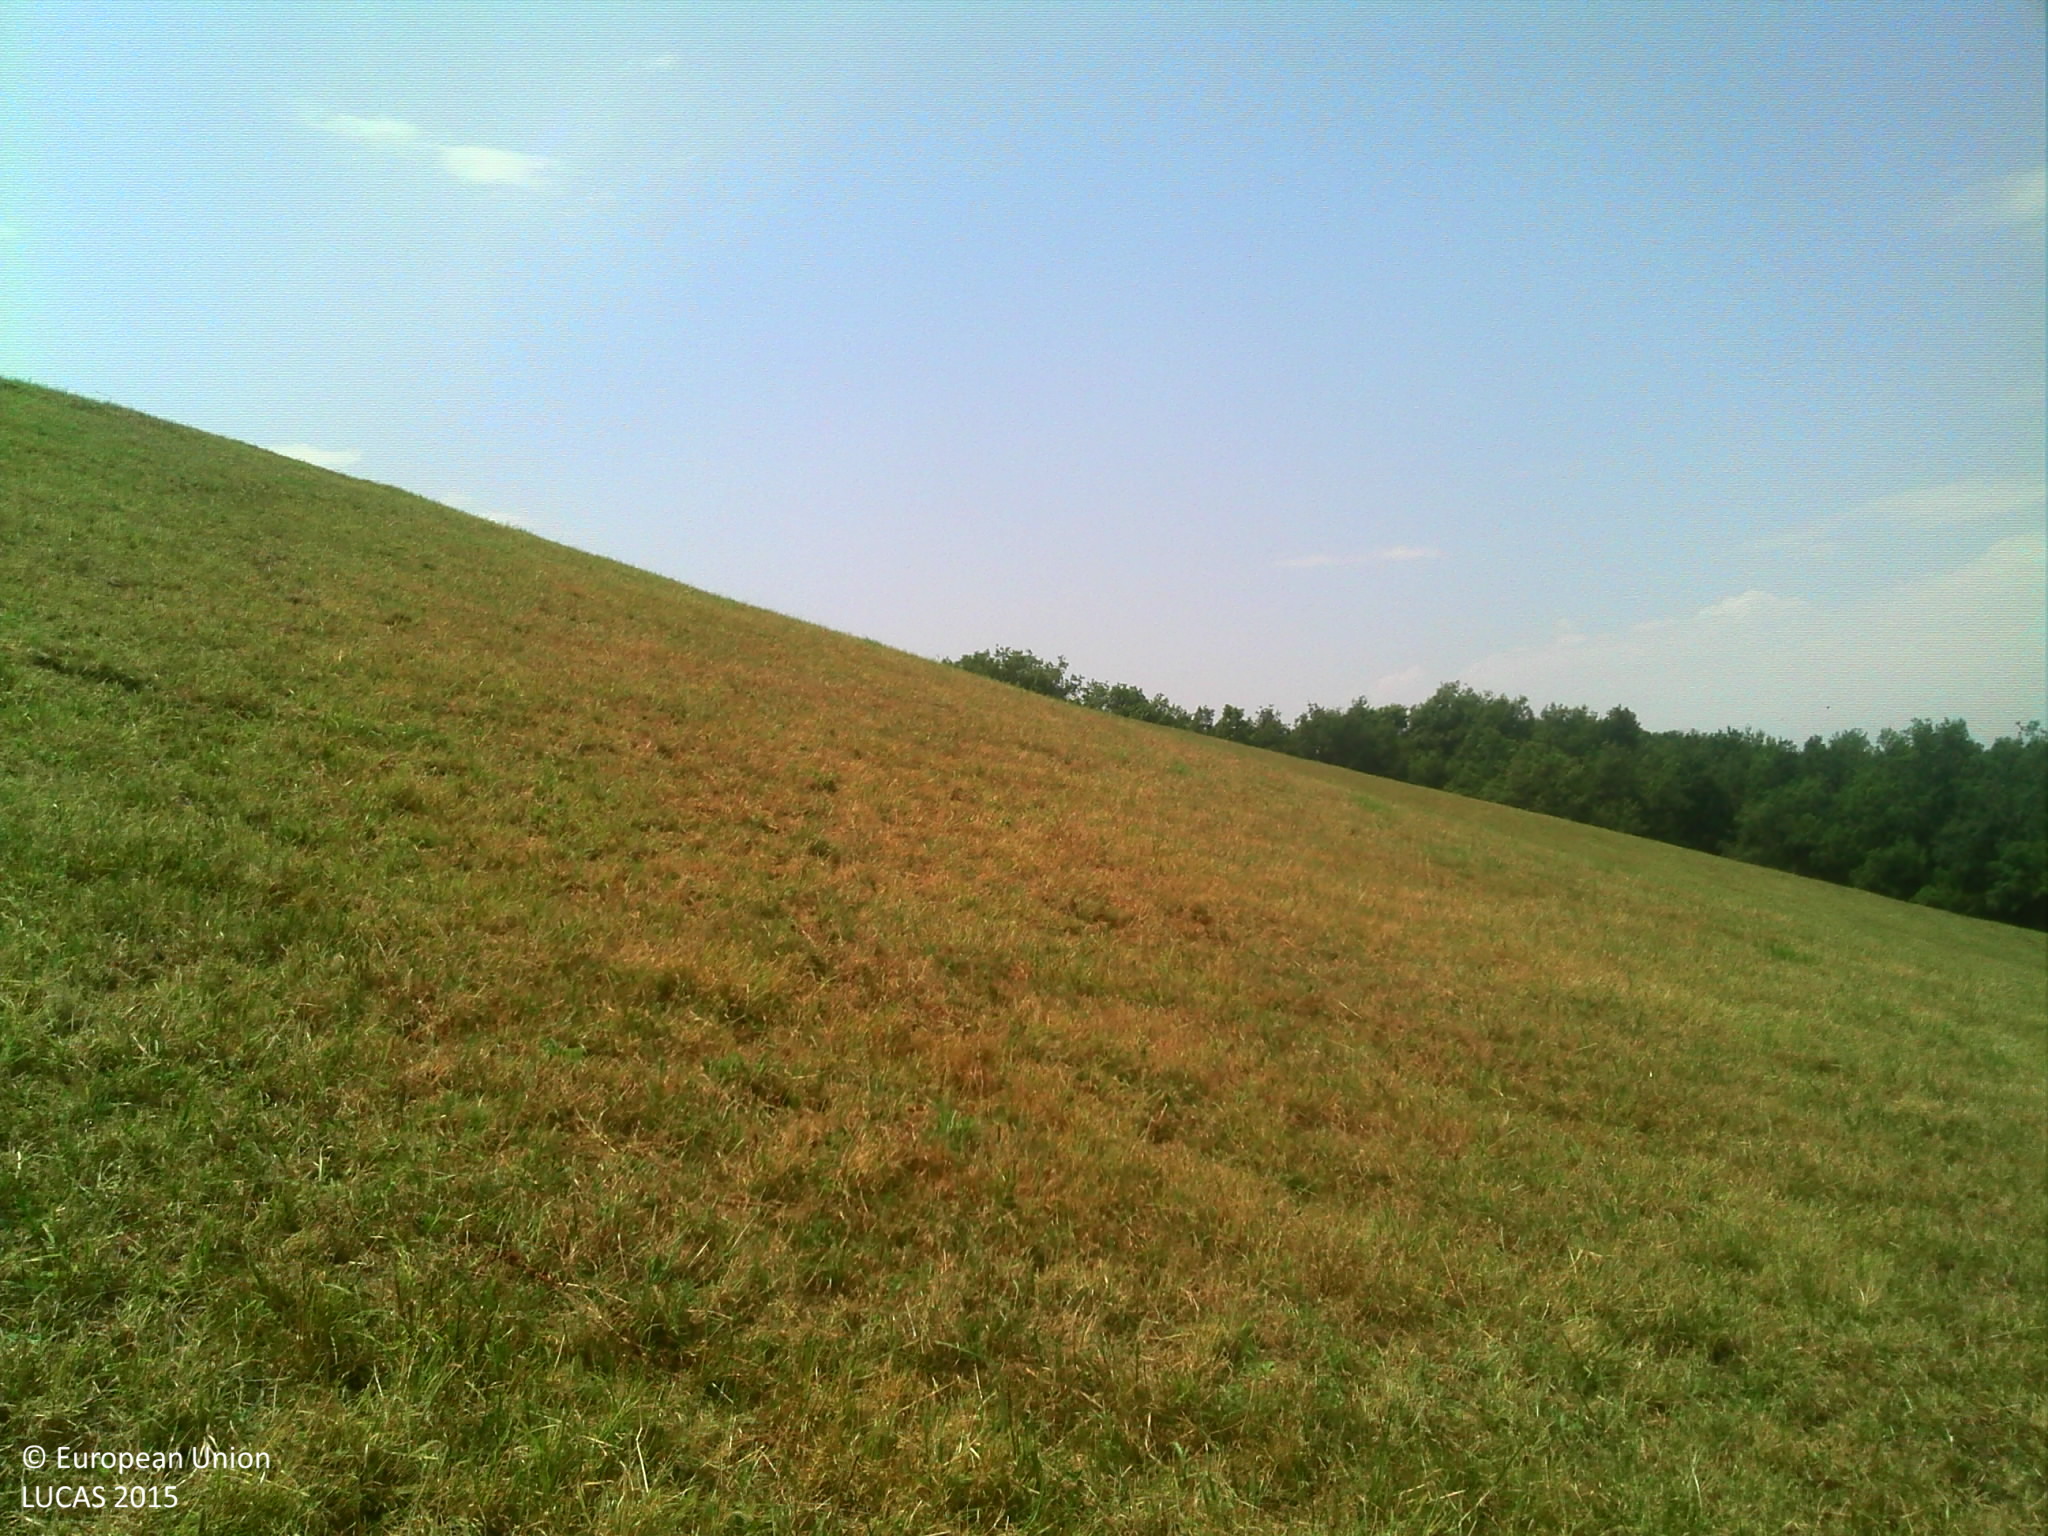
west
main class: Grassland
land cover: Grassland without tree/shrub cover
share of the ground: > 75 %
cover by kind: herbaceous plants 100 %
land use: Agriculture (excluding fallow land and kitchen gardens)
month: July
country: FR
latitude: 43.3275
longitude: 0.8381
